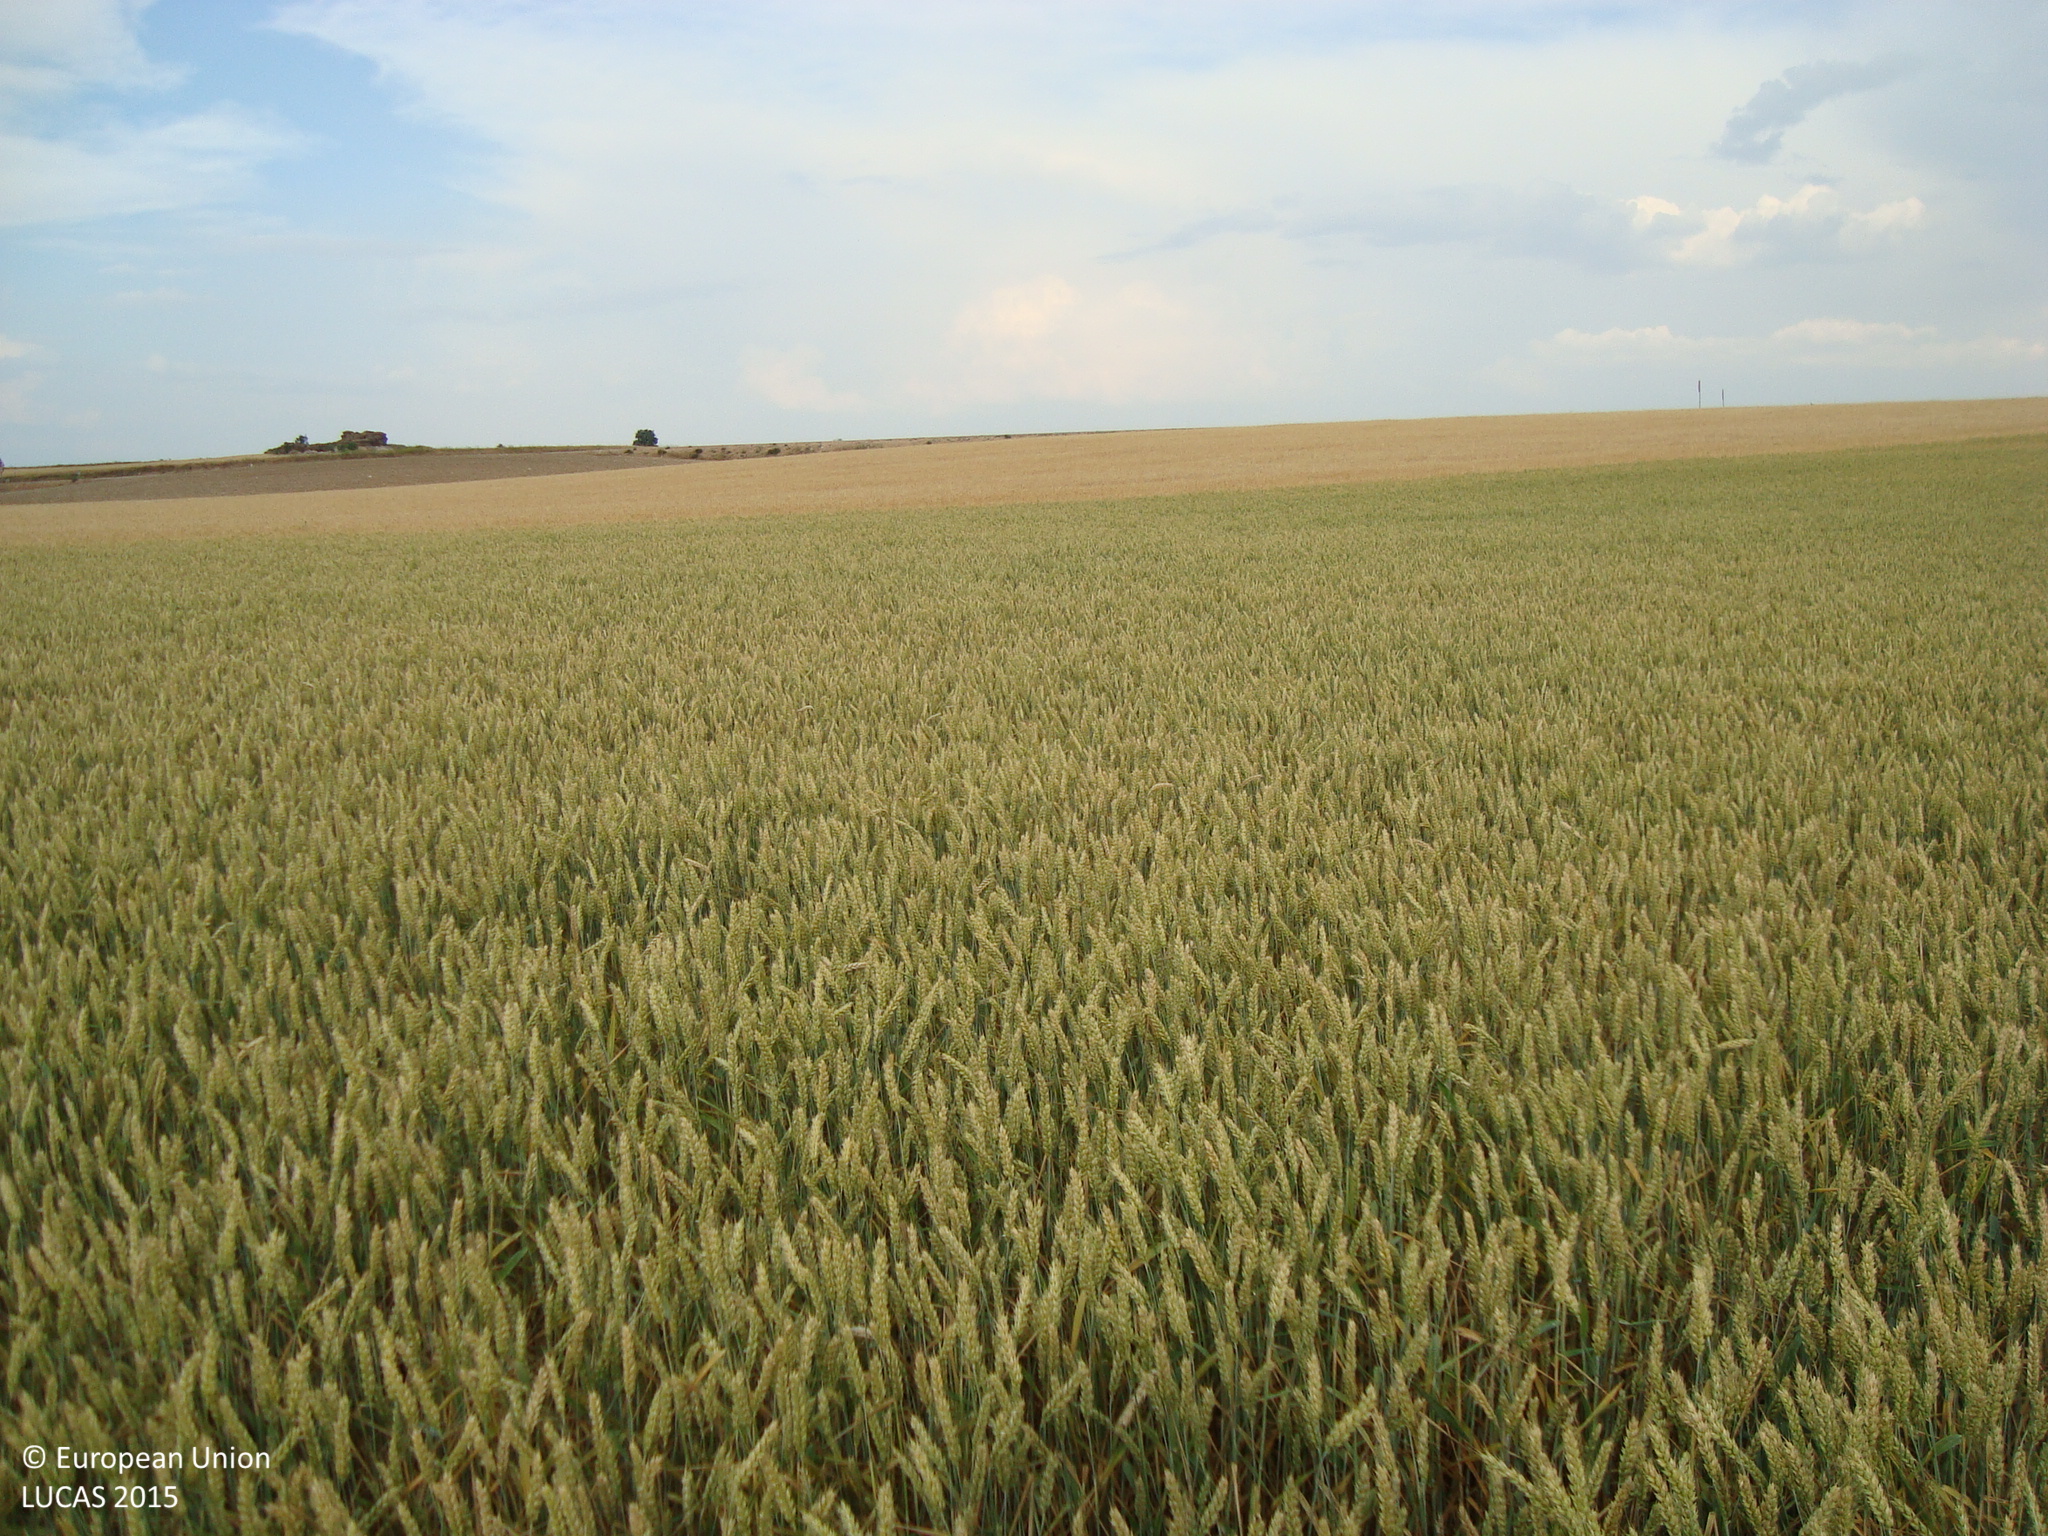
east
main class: Cropland
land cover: Common wheat
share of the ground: > 75 %
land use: Agriculture (excluding fallow land and kitchen gardens)
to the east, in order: Common wheat; Barley; Rape and turnip rape; Paved roads, cycling and walking lanes; Common wheat
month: June
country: ES
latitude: 41.8540
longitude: -3.7758
